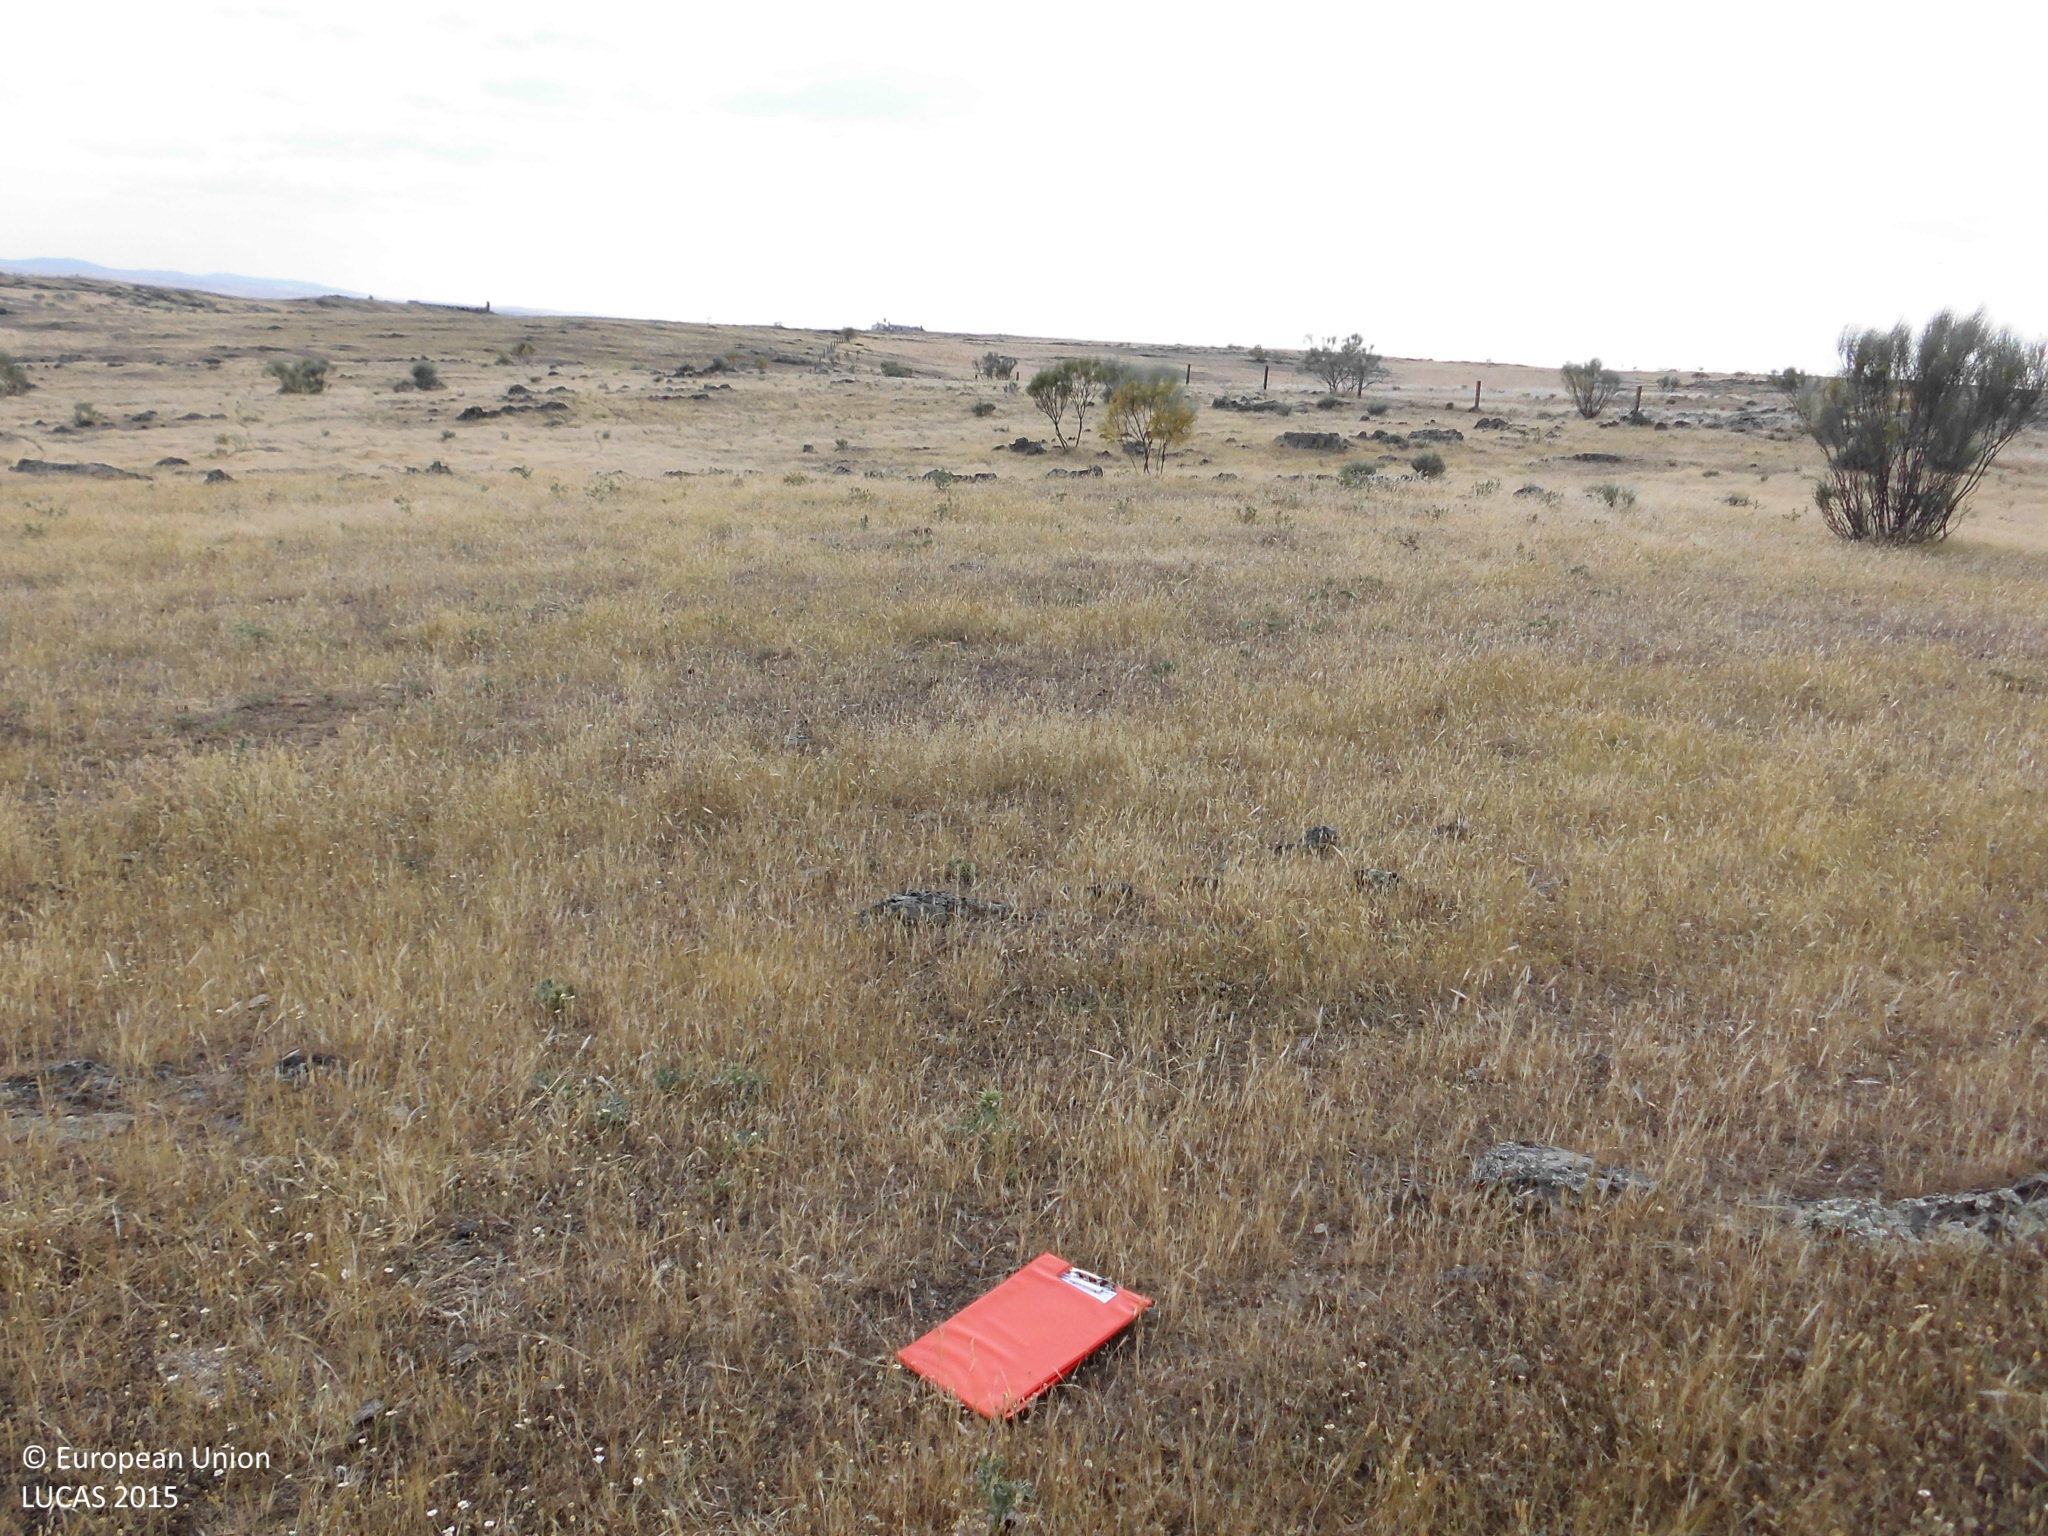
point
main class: Grassland
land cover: Grassland without tree/shrub cover
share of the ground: > 75 %
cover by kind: herbaceous plants 95 %, shrubs 5 %
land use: Agriculture (excluding fallow land and kitchen gardens)
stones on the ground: < 10 %
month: May
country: ES
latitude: 39.5592
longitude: -6.0667
